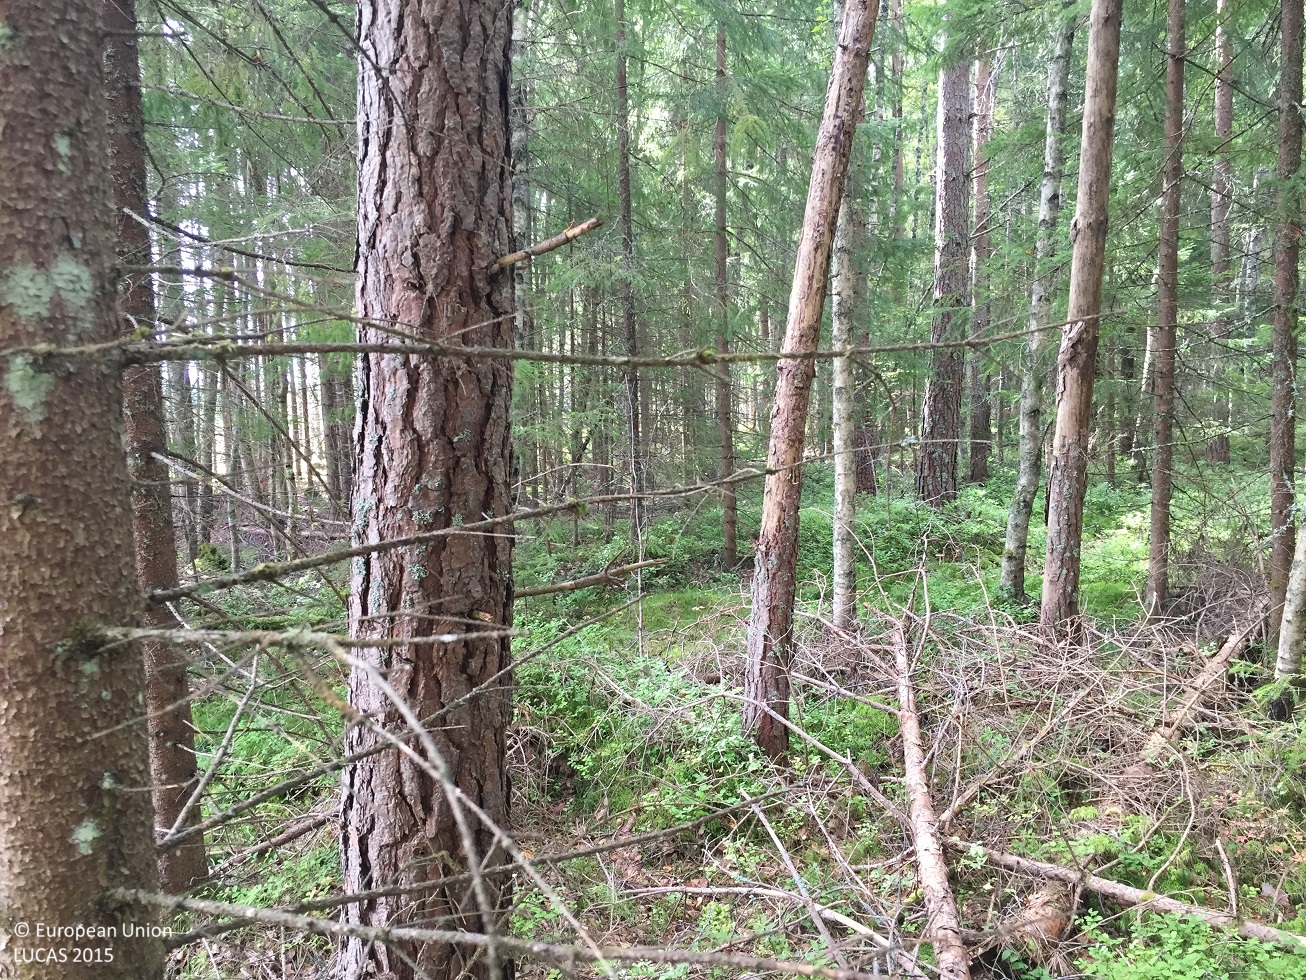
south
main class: Woodland
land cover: Spruce dominated mixed woodland
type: boreal forest
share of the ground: 50 - 75 %
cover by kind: coniferous forest trees 50 %, broadleaved forest trees 25 %, shrubs 15 %, lichens and mosses 10 %
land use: Forestry
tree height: > 5 m
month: August
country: SE
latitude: 59.6758
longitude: 13.2060
